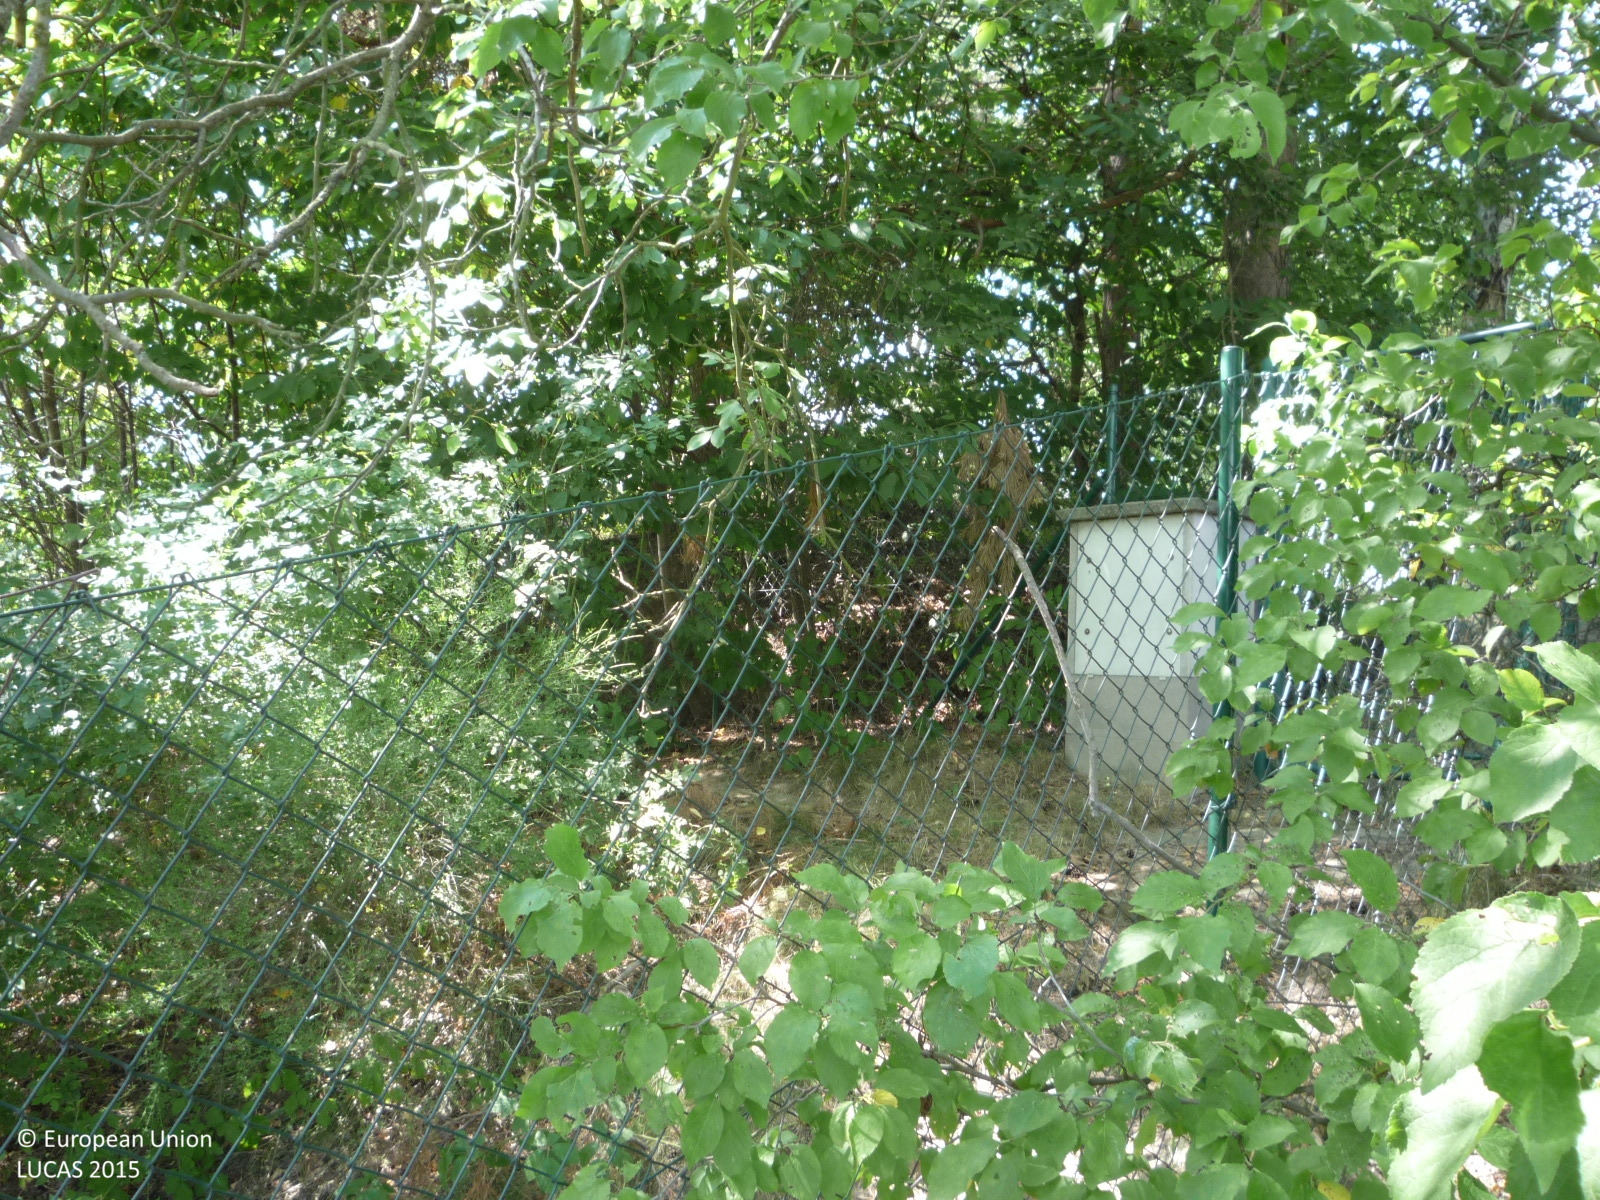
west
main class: Cropland
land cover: Apple fruit
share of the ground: > 75 %
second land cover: Grassland without tree/shrub cover
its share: < 10 %
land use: Kitchen garden
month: August
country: CZ
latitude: 50.5875
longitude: 15.2153
